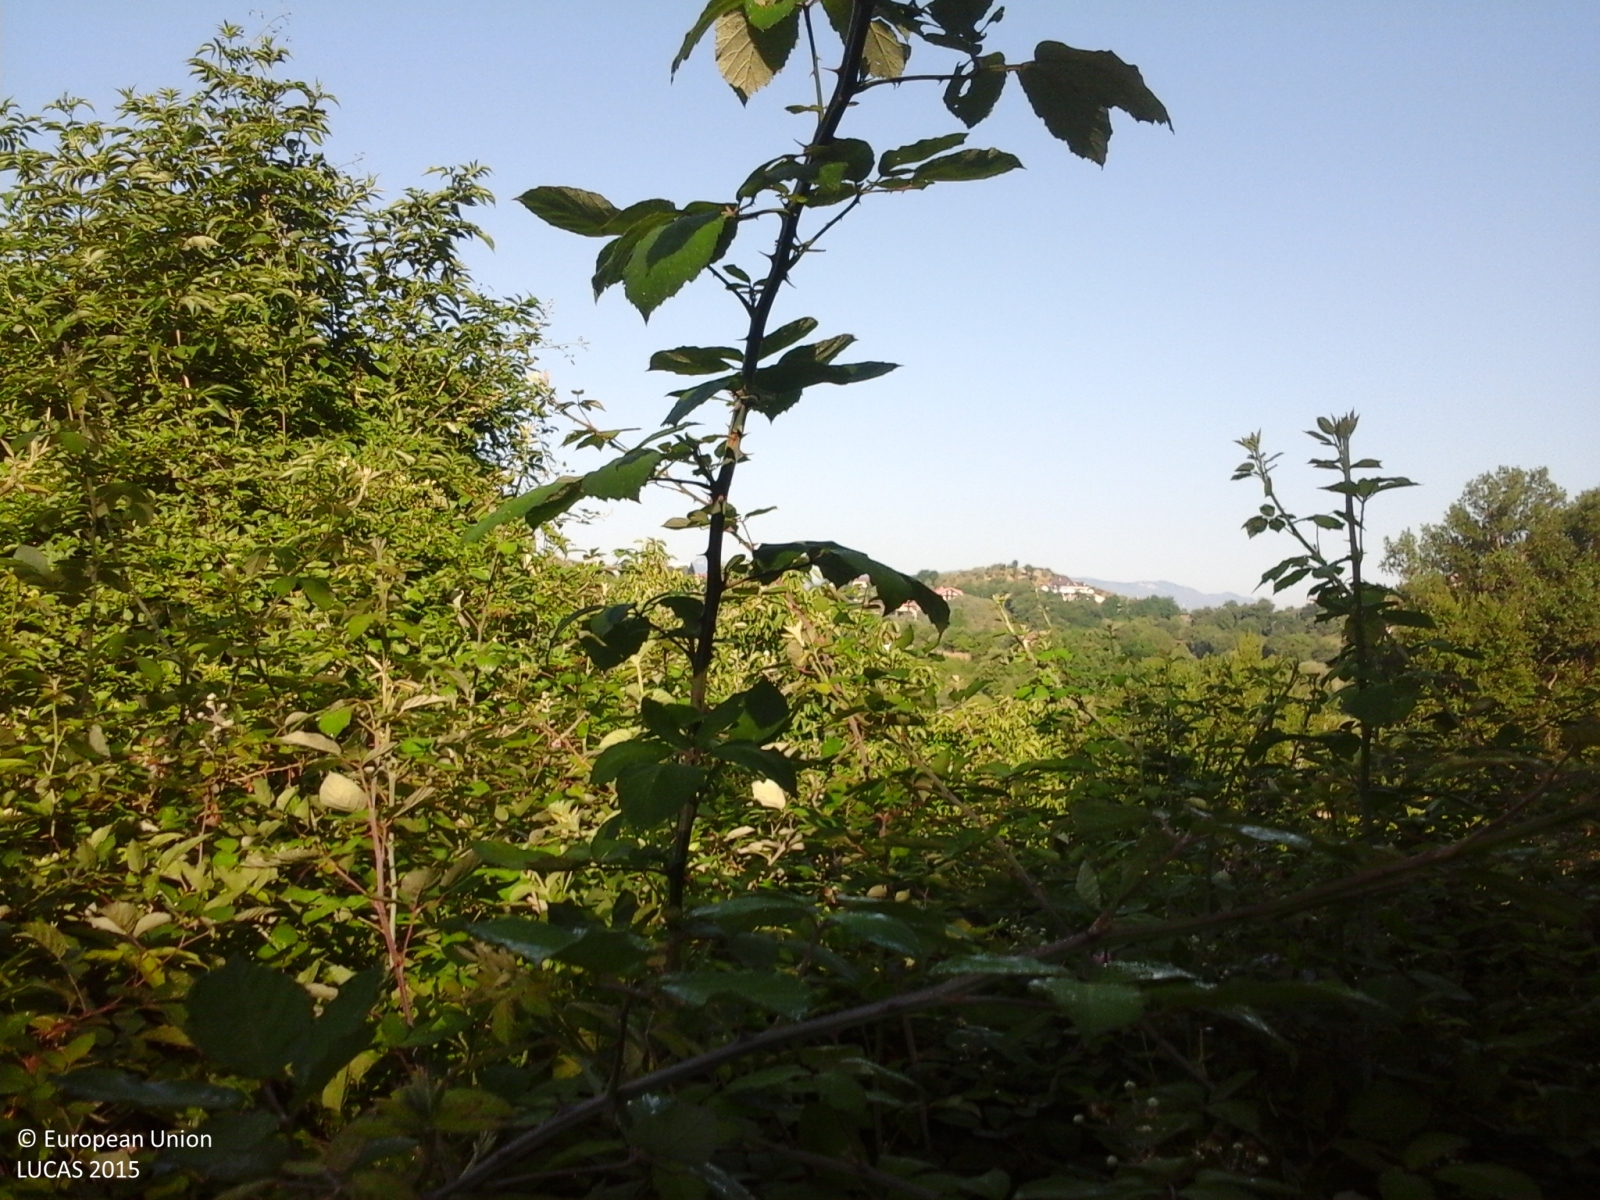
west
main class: Woodland
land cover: Broadleaved woodland
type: thermophilous deciduous forest
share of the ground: > 75 %
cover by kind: shrubs 70 %, broadleaved forest trees 15 %, herbaceous plants 15 %
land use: Abandoned areas
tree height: < 5 m
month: June
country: IT
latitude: 41.6202
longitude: 13.4076
